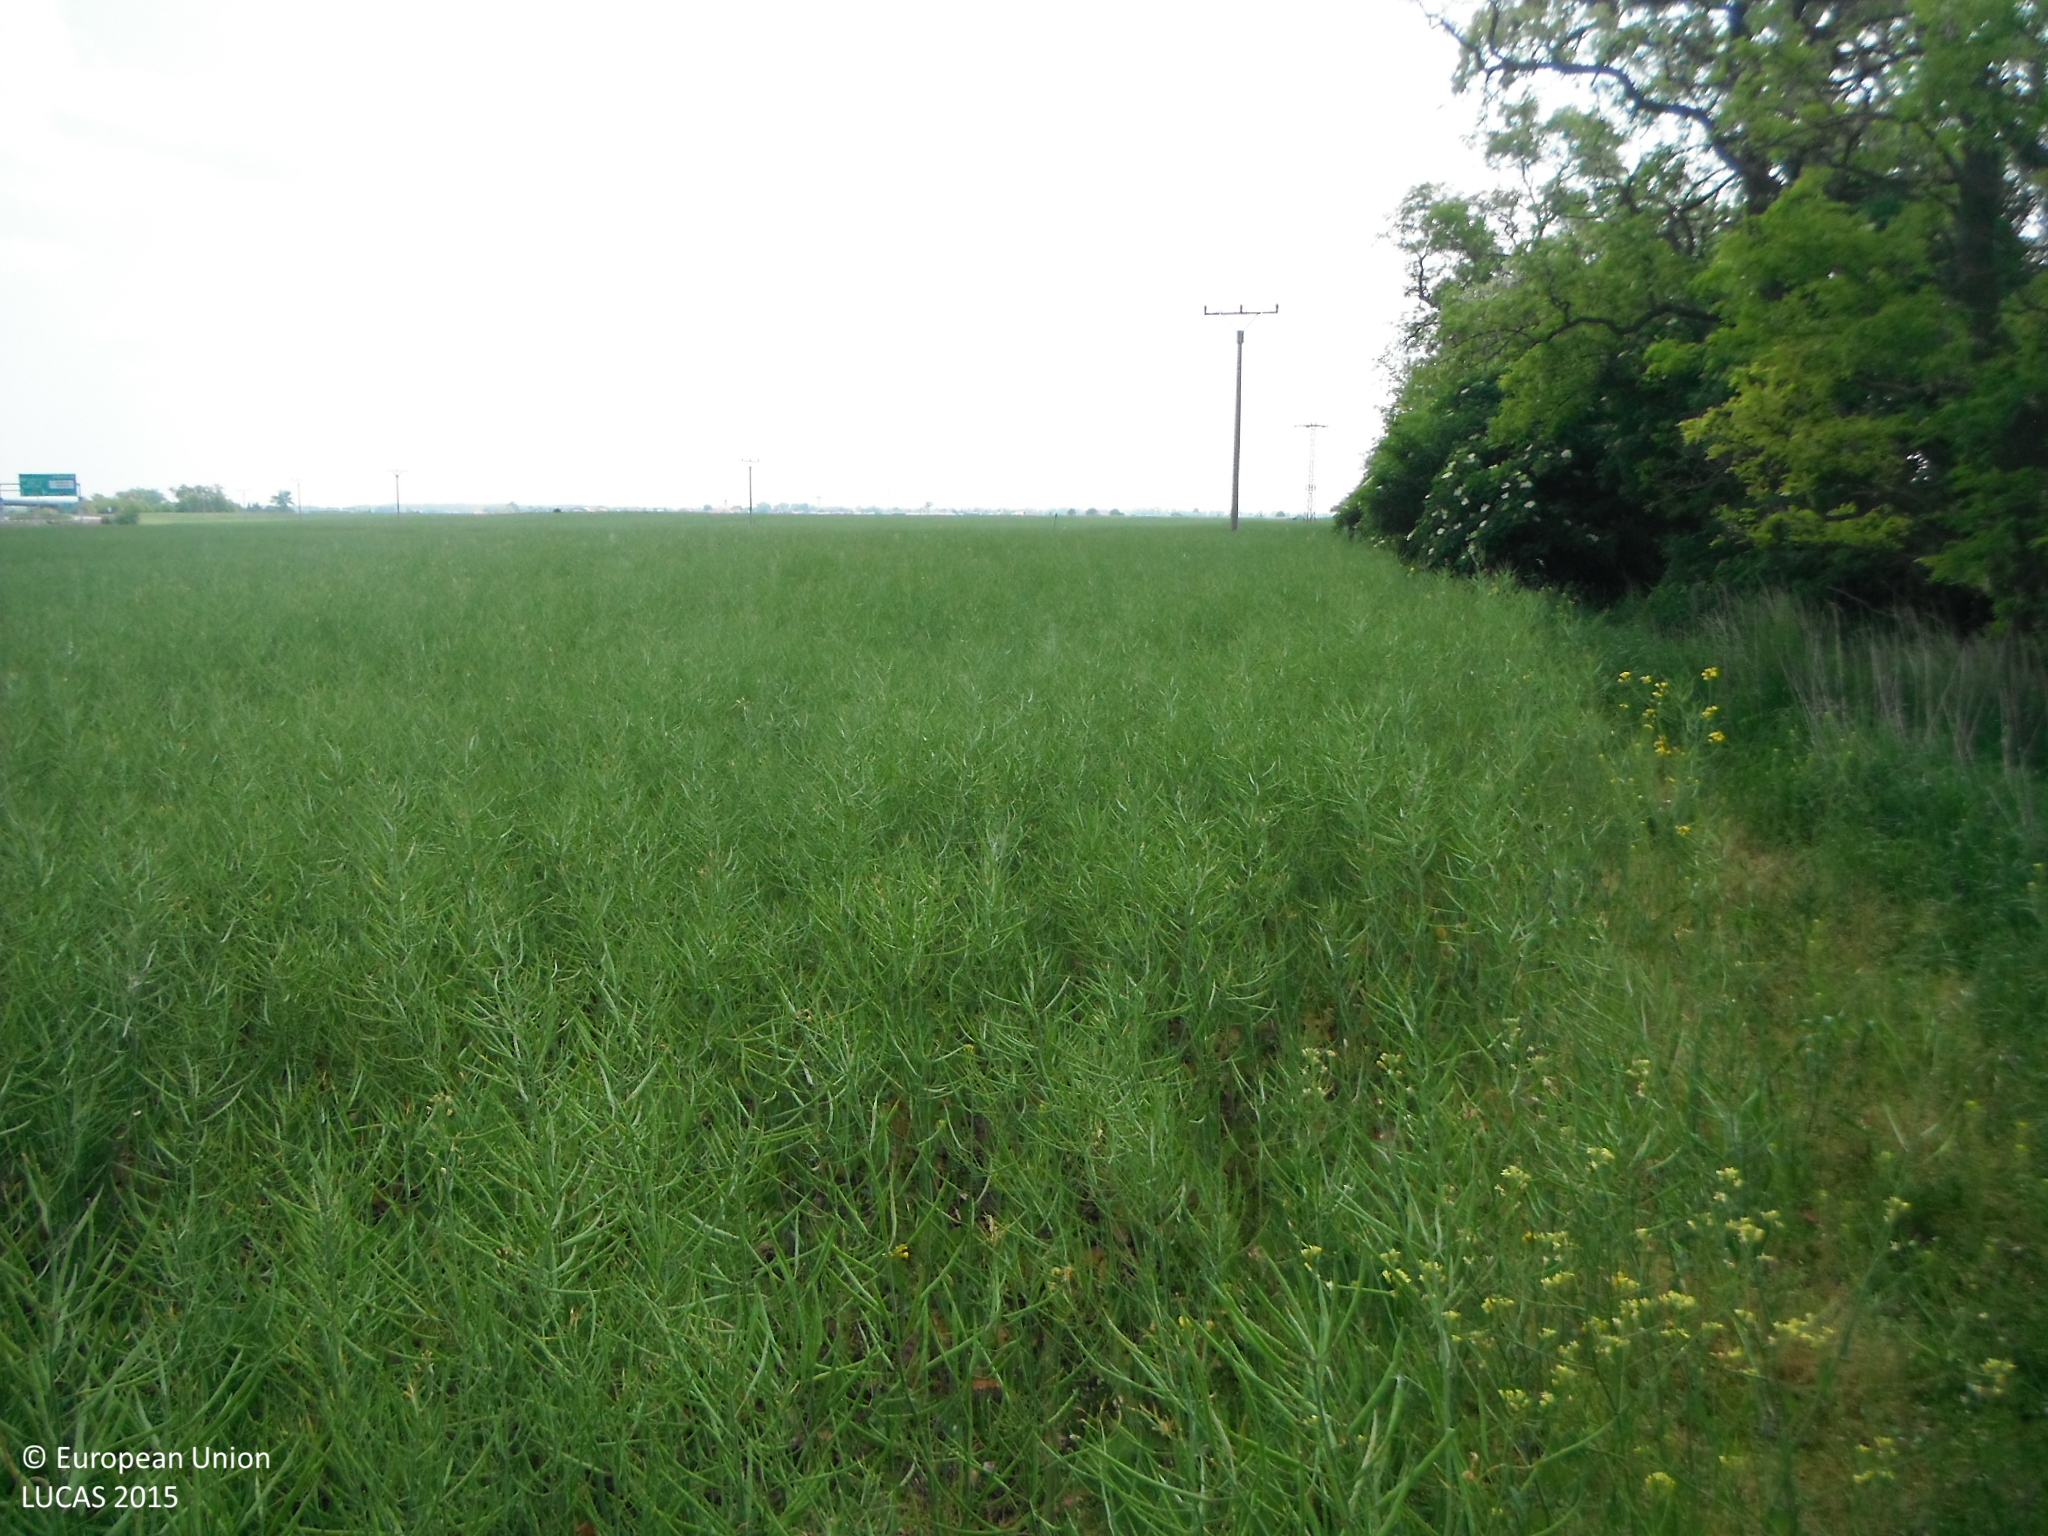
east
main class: Cropland
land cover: Rape and turnip rape
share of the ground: > 75 %
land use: Agriculture (excluding fallow land and kitchen gardens)
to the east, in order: Rape and turnip rape
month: May
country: SK
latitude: 48.0680
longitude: 17.0800
